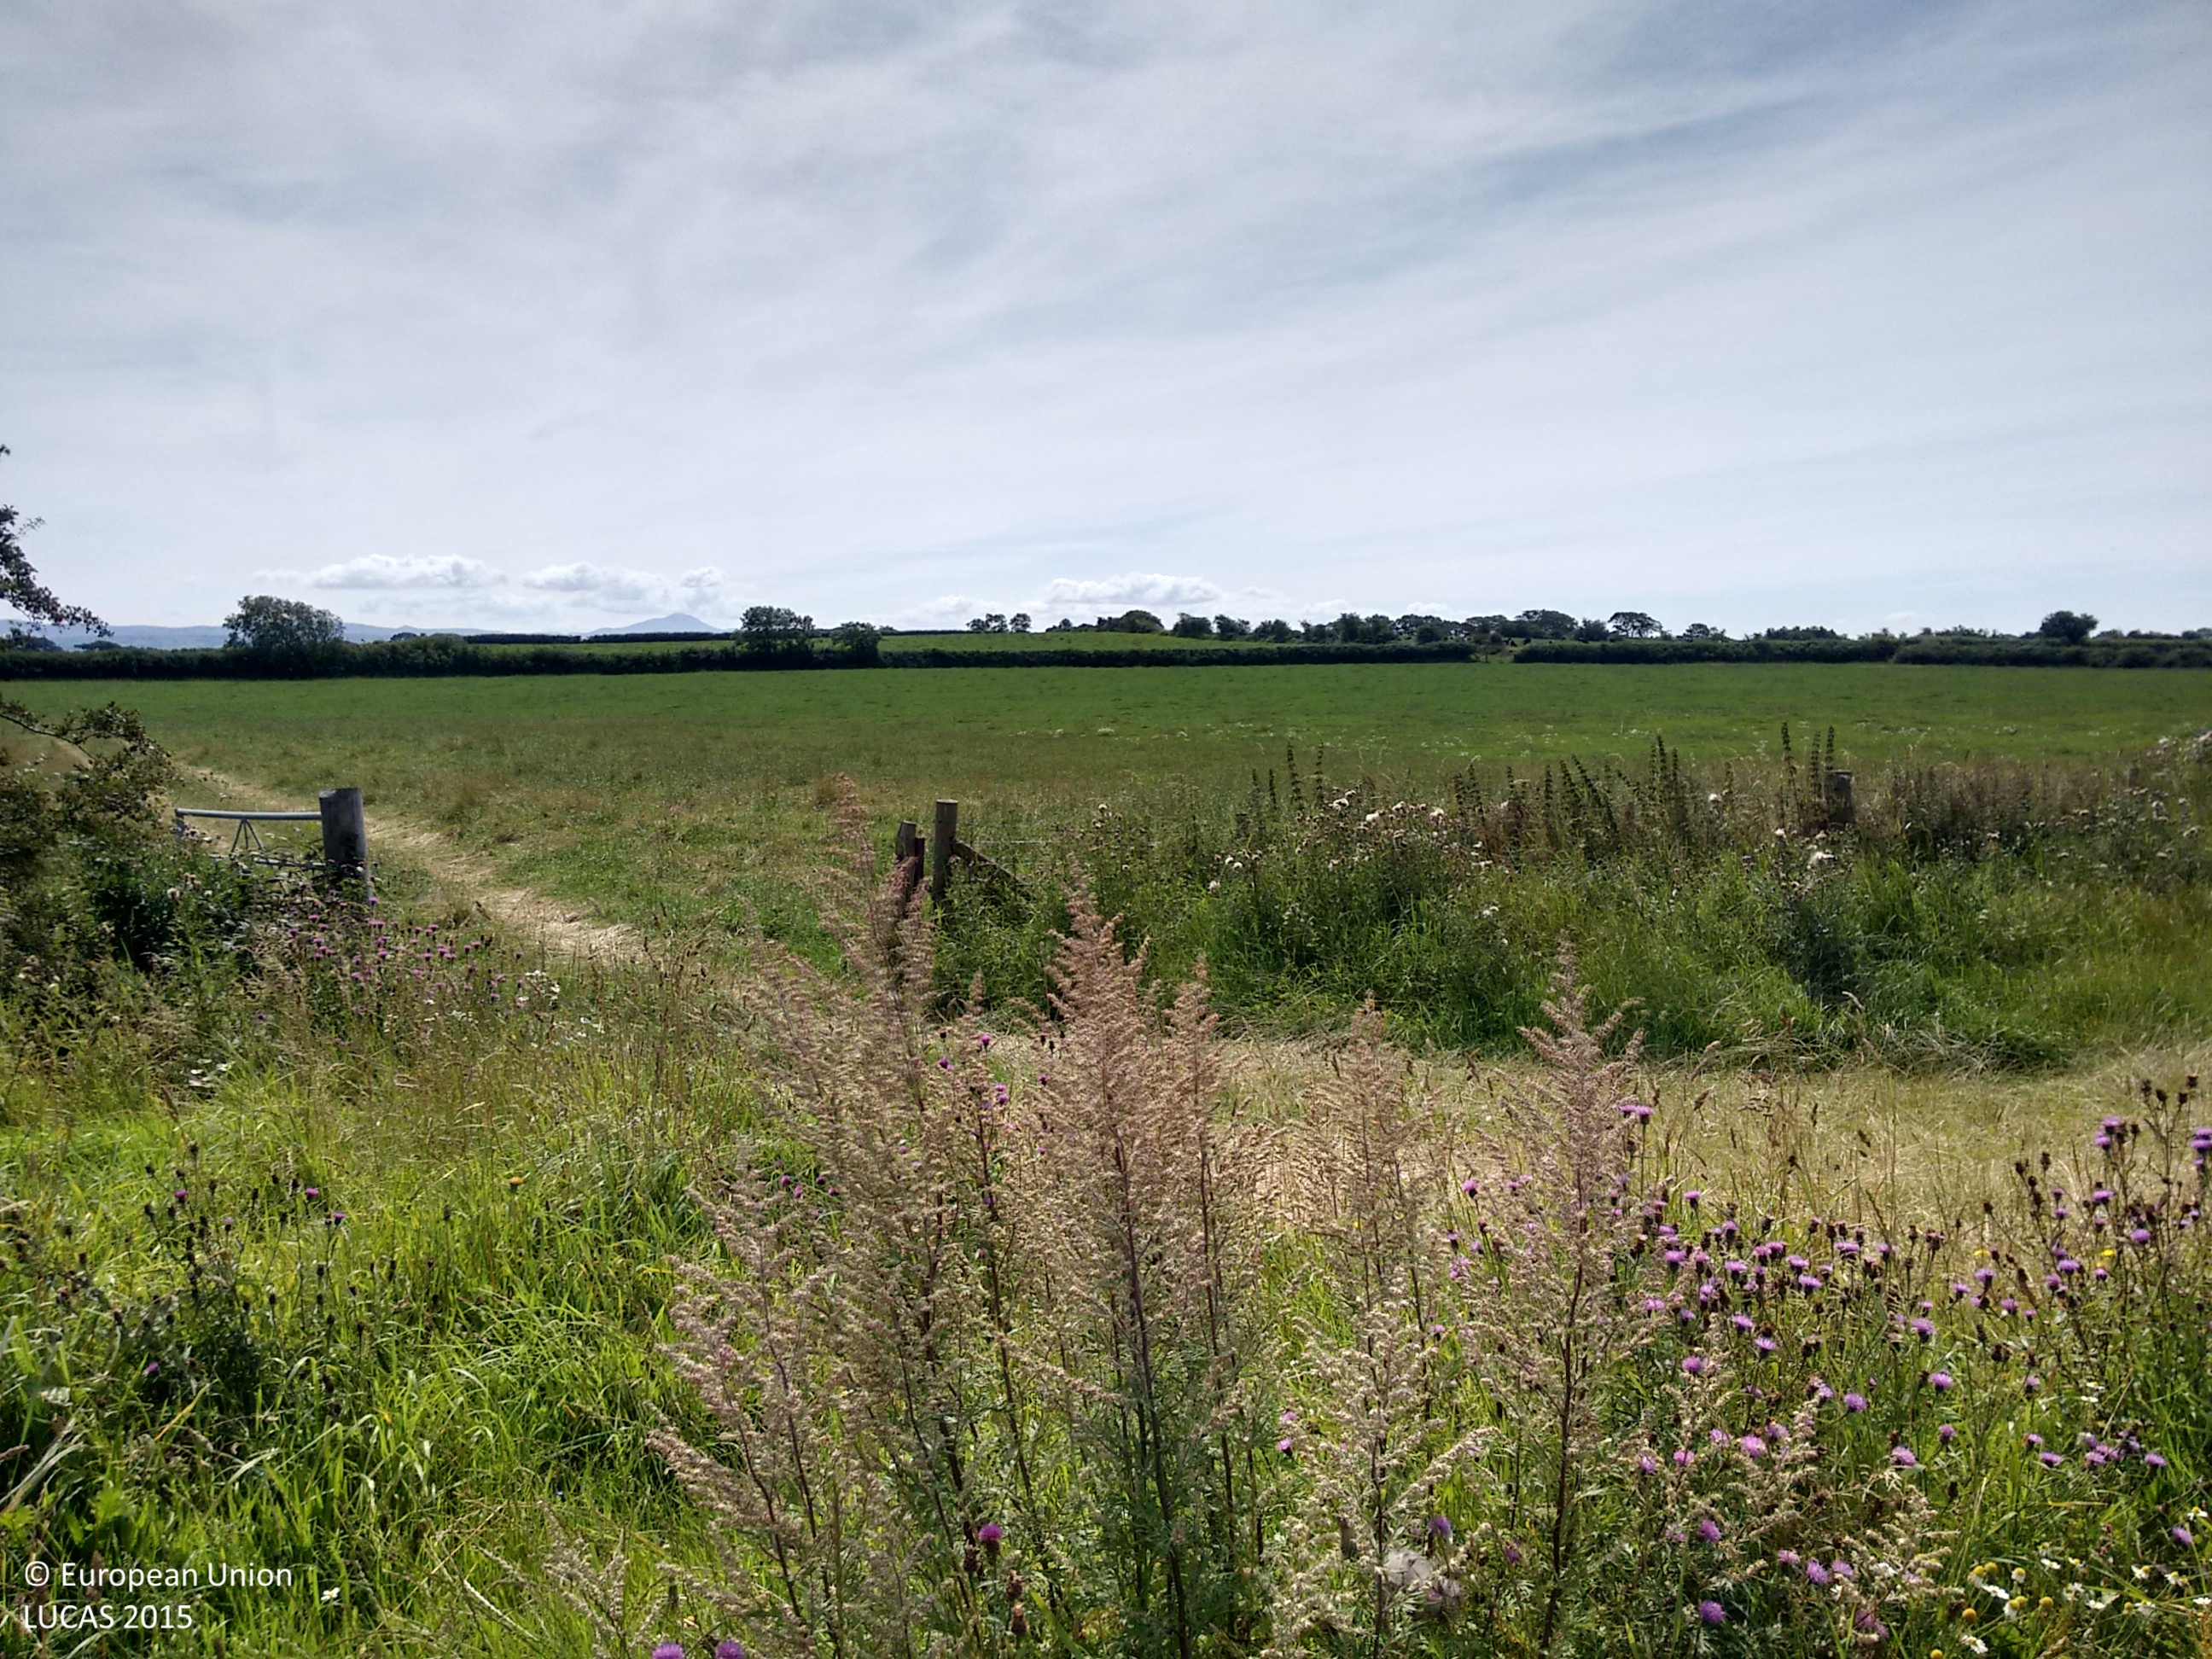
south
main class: Cropland
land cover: Barley
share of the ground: > 75 %
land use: Agriculture (excluding fallow land and kitchen gardens)
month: August
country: GB
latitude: 54.8767
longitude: -3.2456
